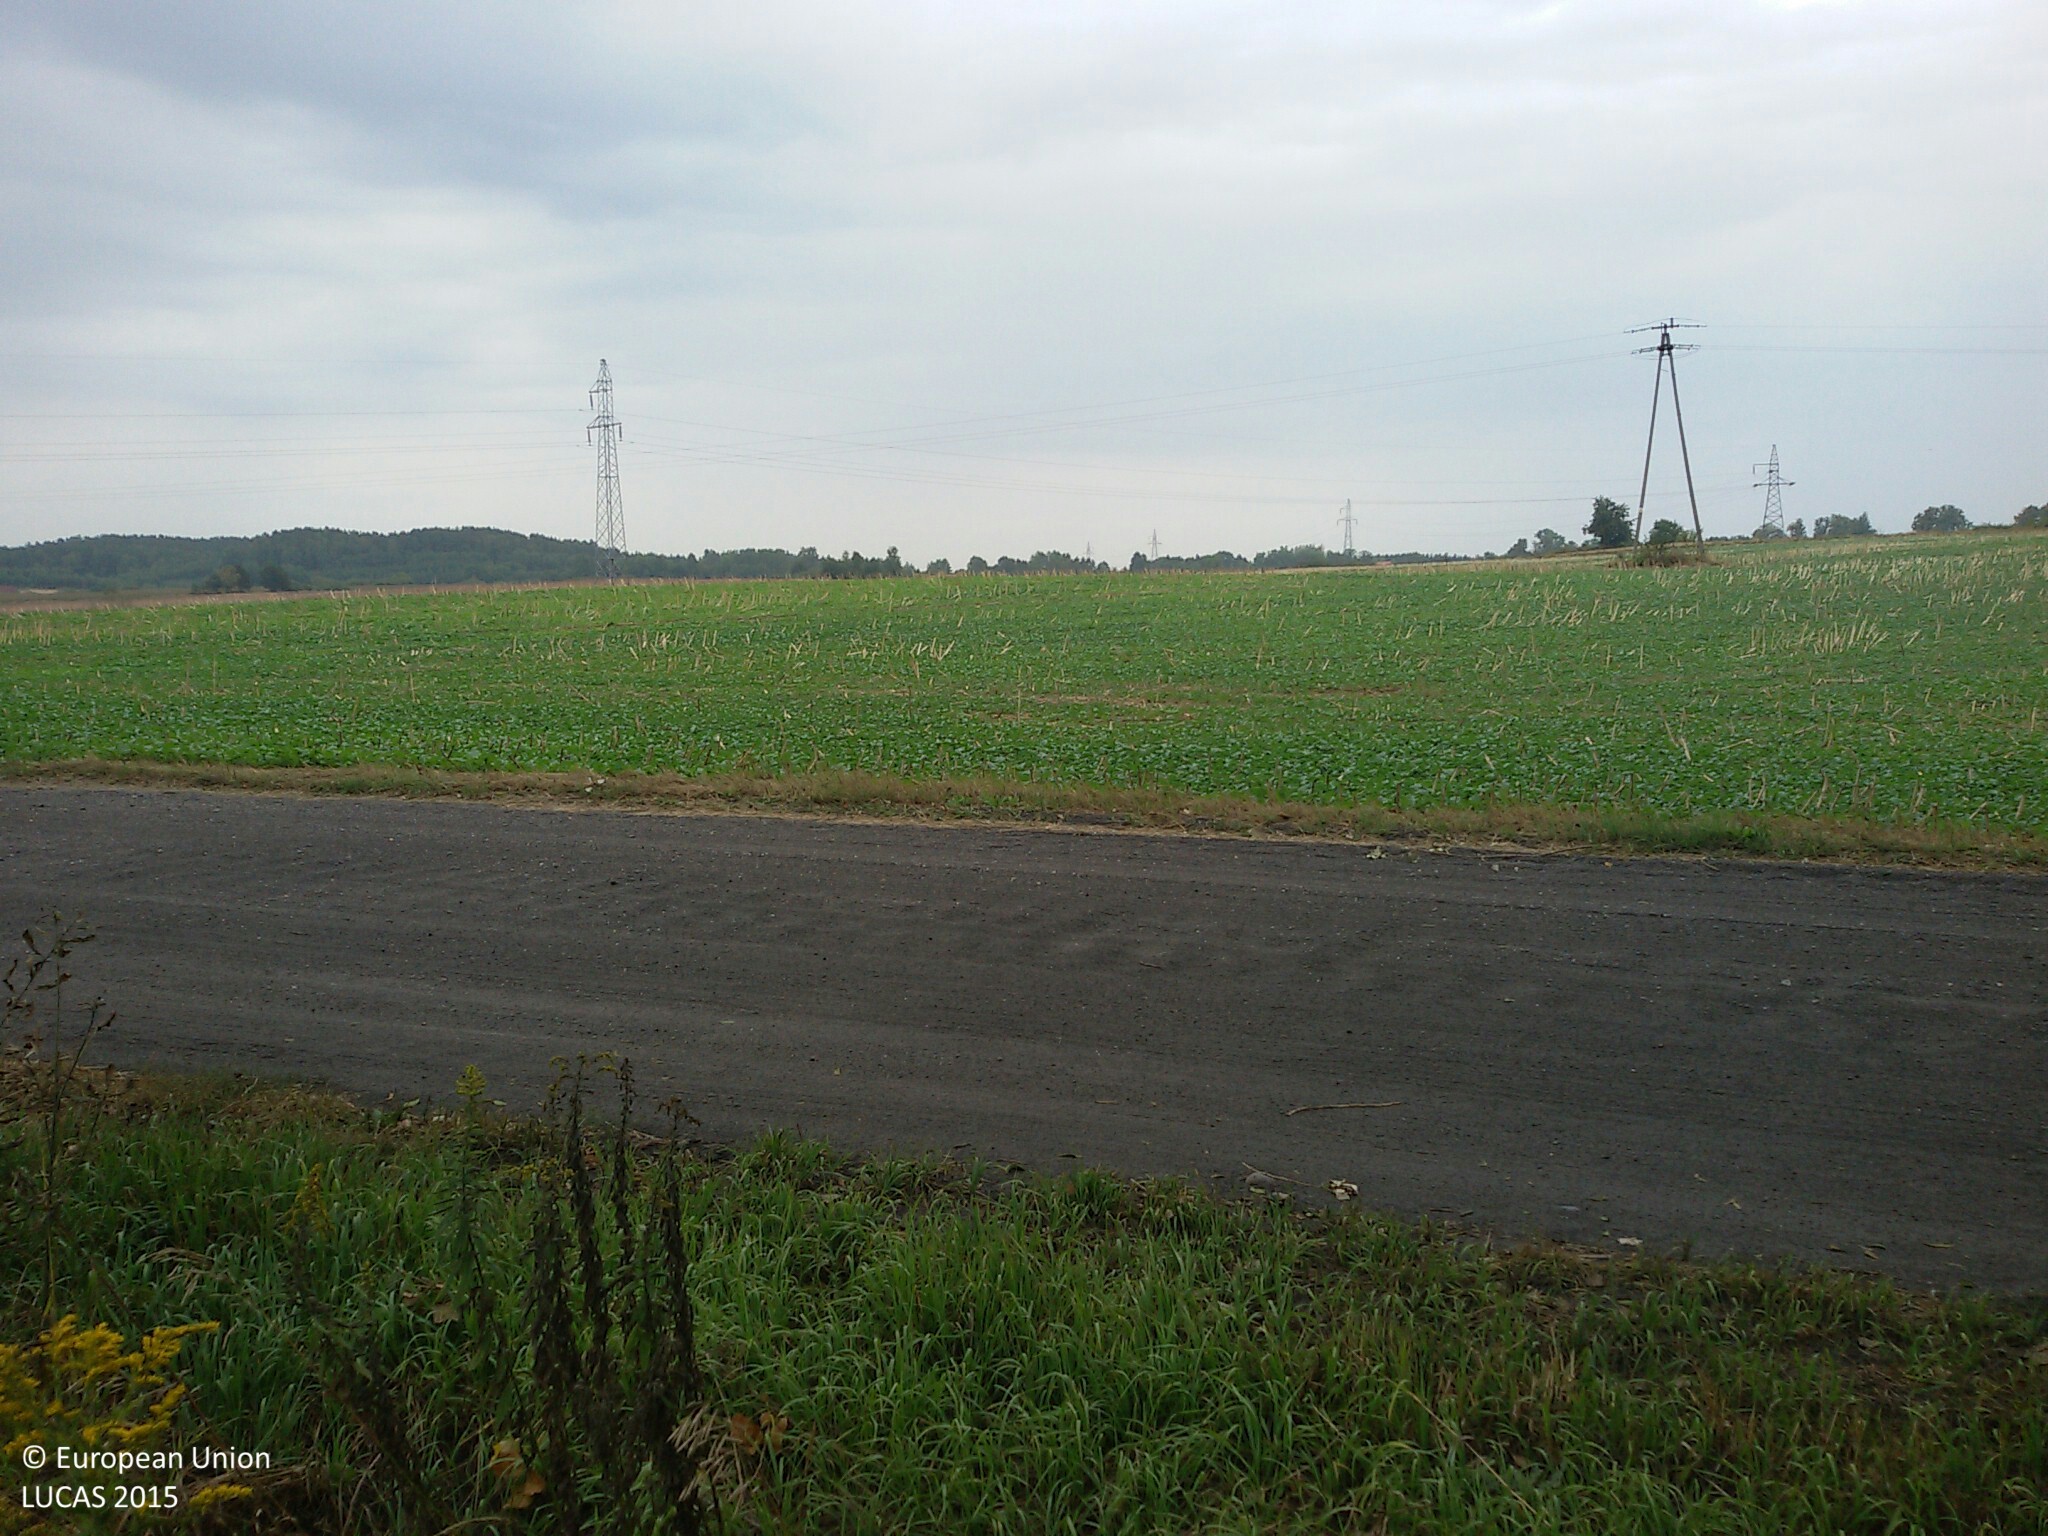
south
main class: Grassland
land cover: Grassland with sparse tree/shrub cover
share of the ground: > 75 %
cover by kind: herbaceous plants 85 %, shrubs 10 %, broadleaved forest trees 5 %
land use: Abandoned areas
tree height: > 5 m
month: September
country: PL
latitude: 53.7311
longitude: 20.2047
